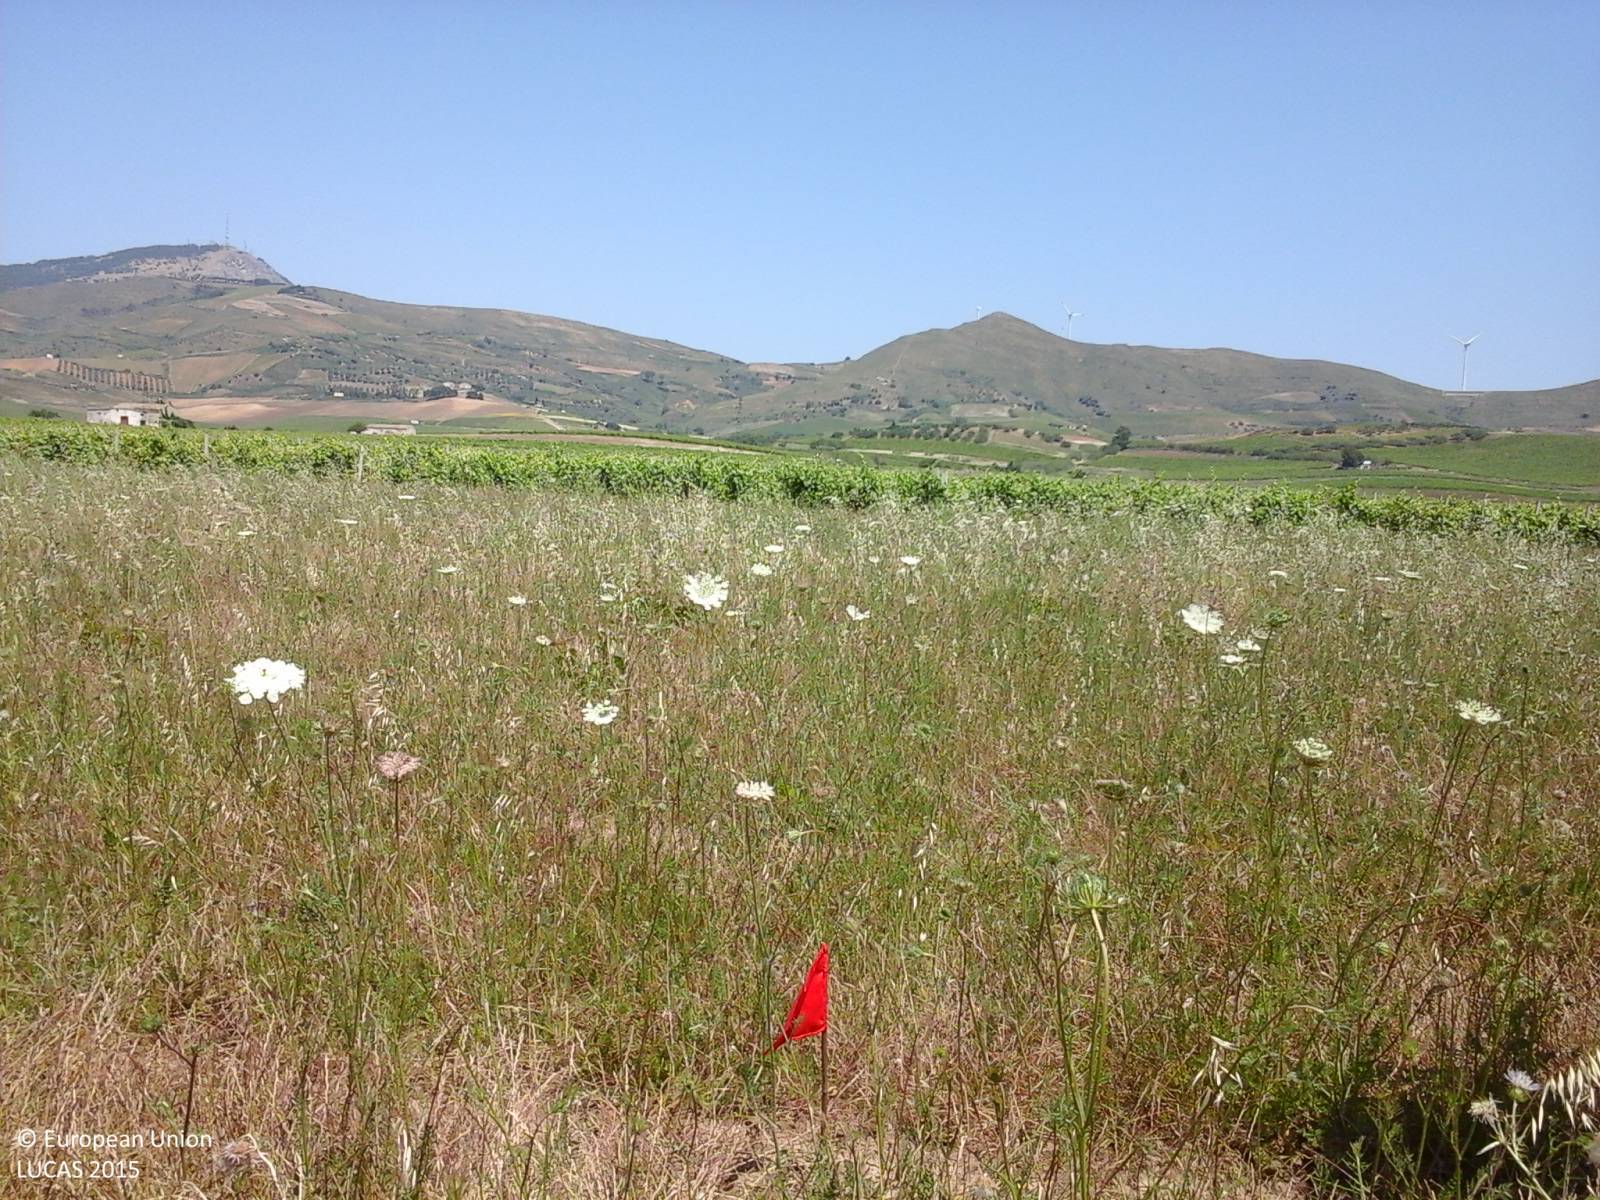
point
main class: Grassland
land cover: Grassland without tree/shrub cover
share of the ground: > 75 %
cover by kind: herbaceous plants 100 %
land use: Abandoned areas
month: June
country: IT
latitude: 37.9184
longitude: 12.9927
